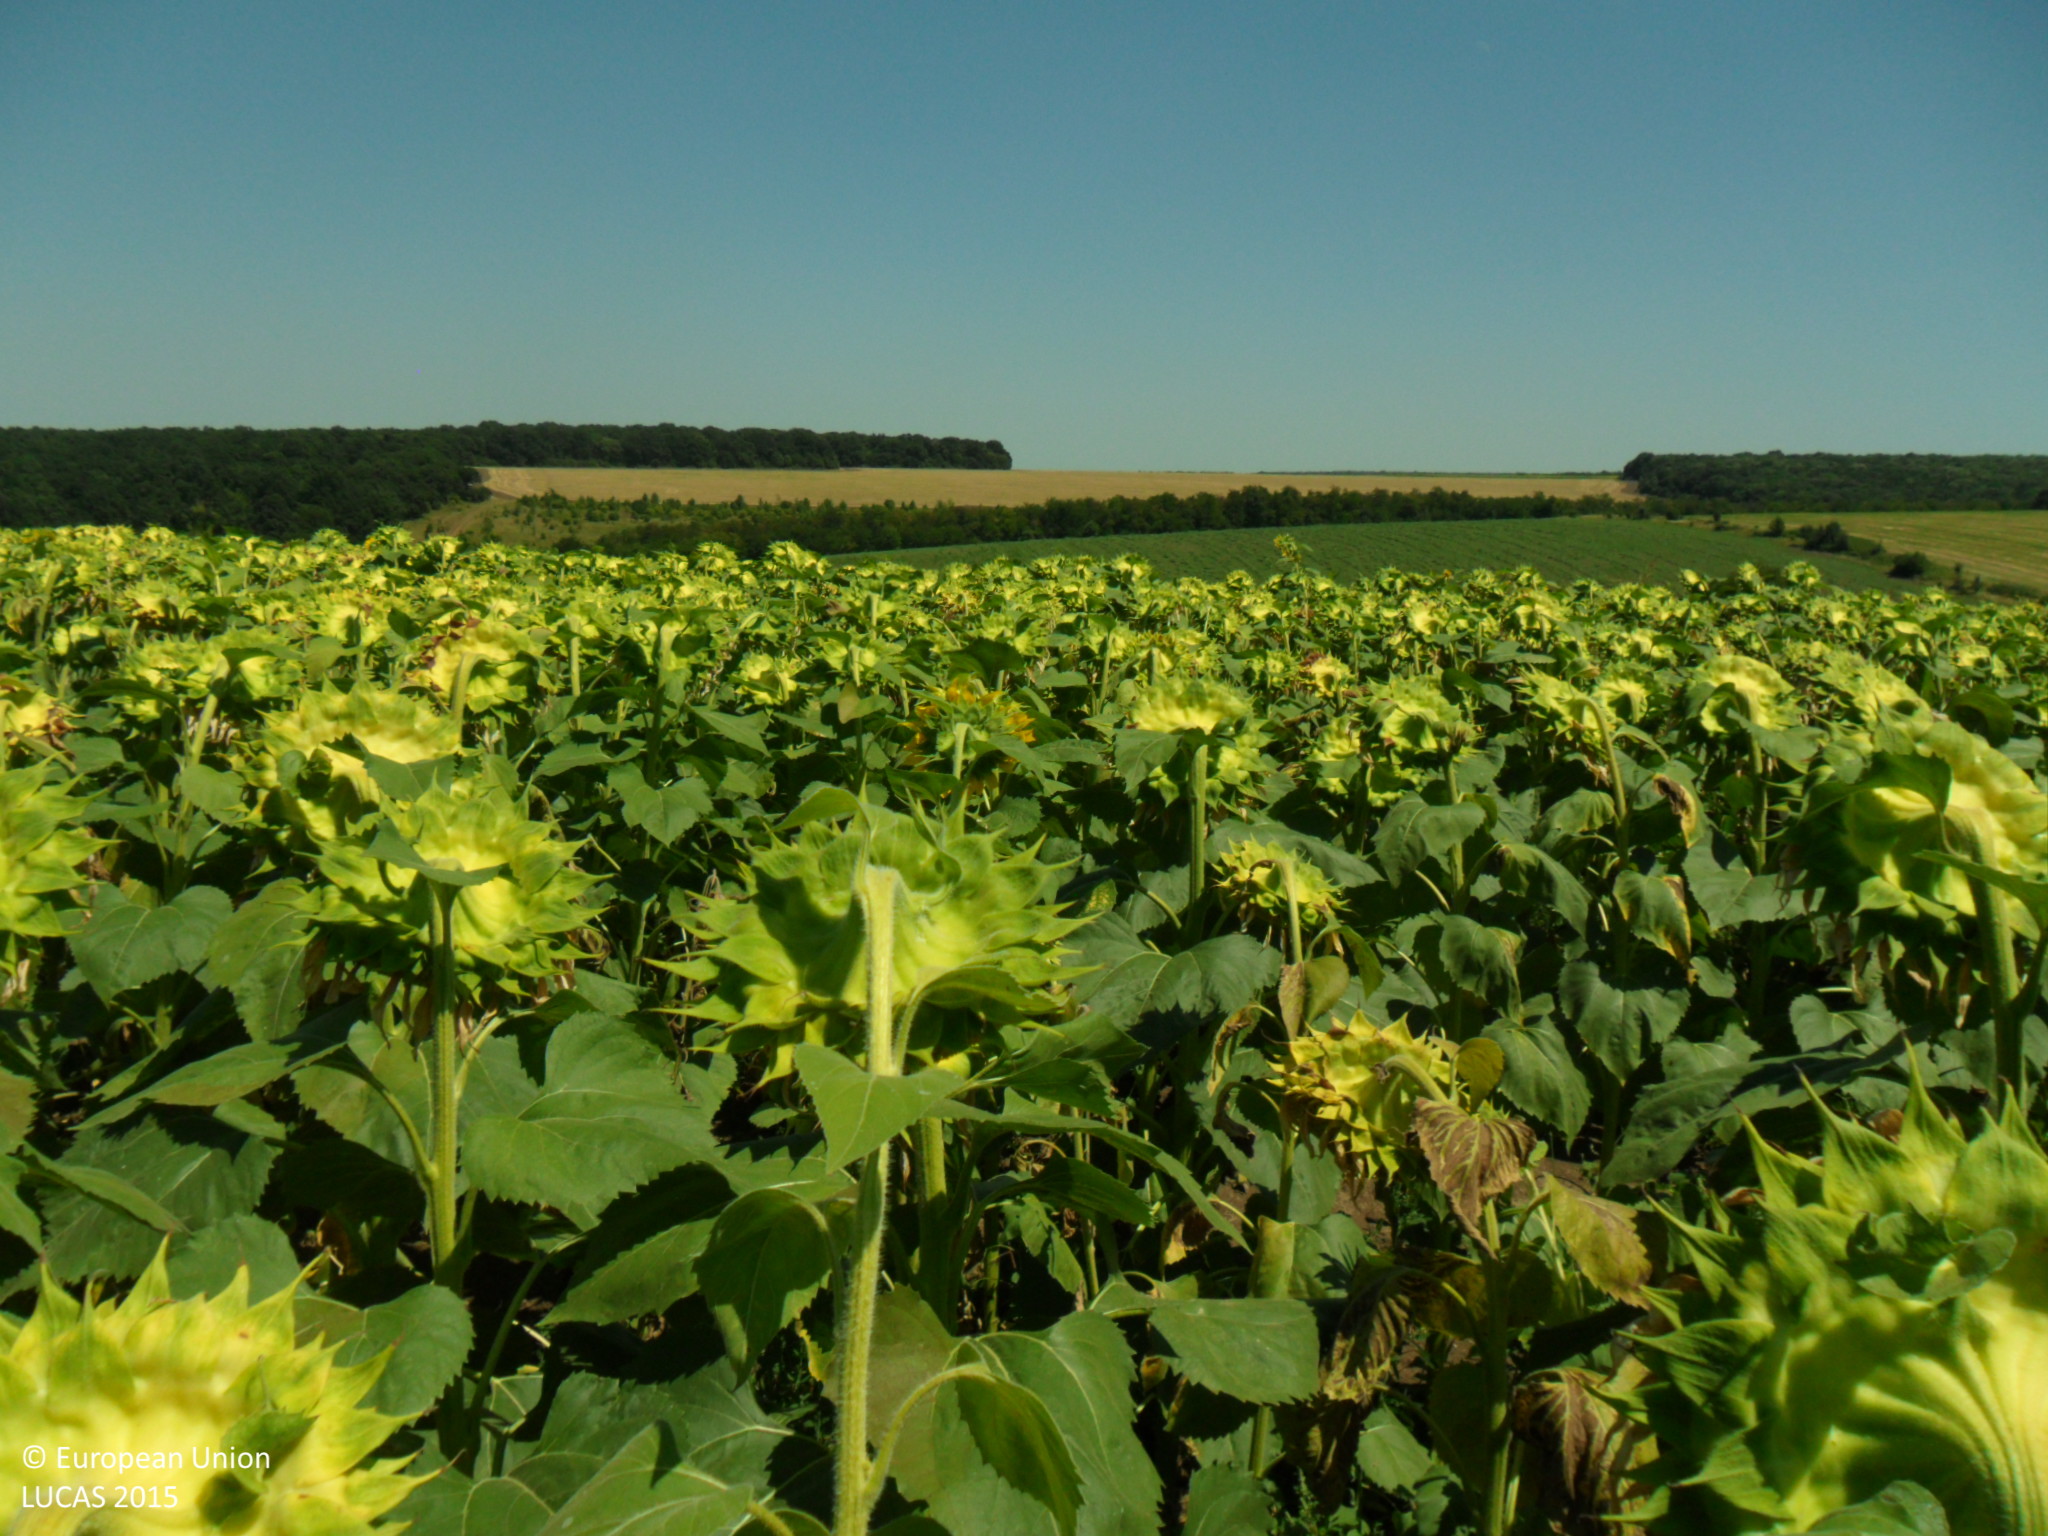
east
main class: Cropland
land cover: Sunflower
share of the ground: > 75 %
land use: Agriculture (excluding fallow land and kitchen gardens)
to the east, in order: Sunflower; Spontaneously vegetated surfaces
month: July
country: BG
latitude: 43.8415
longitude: 26.4123
